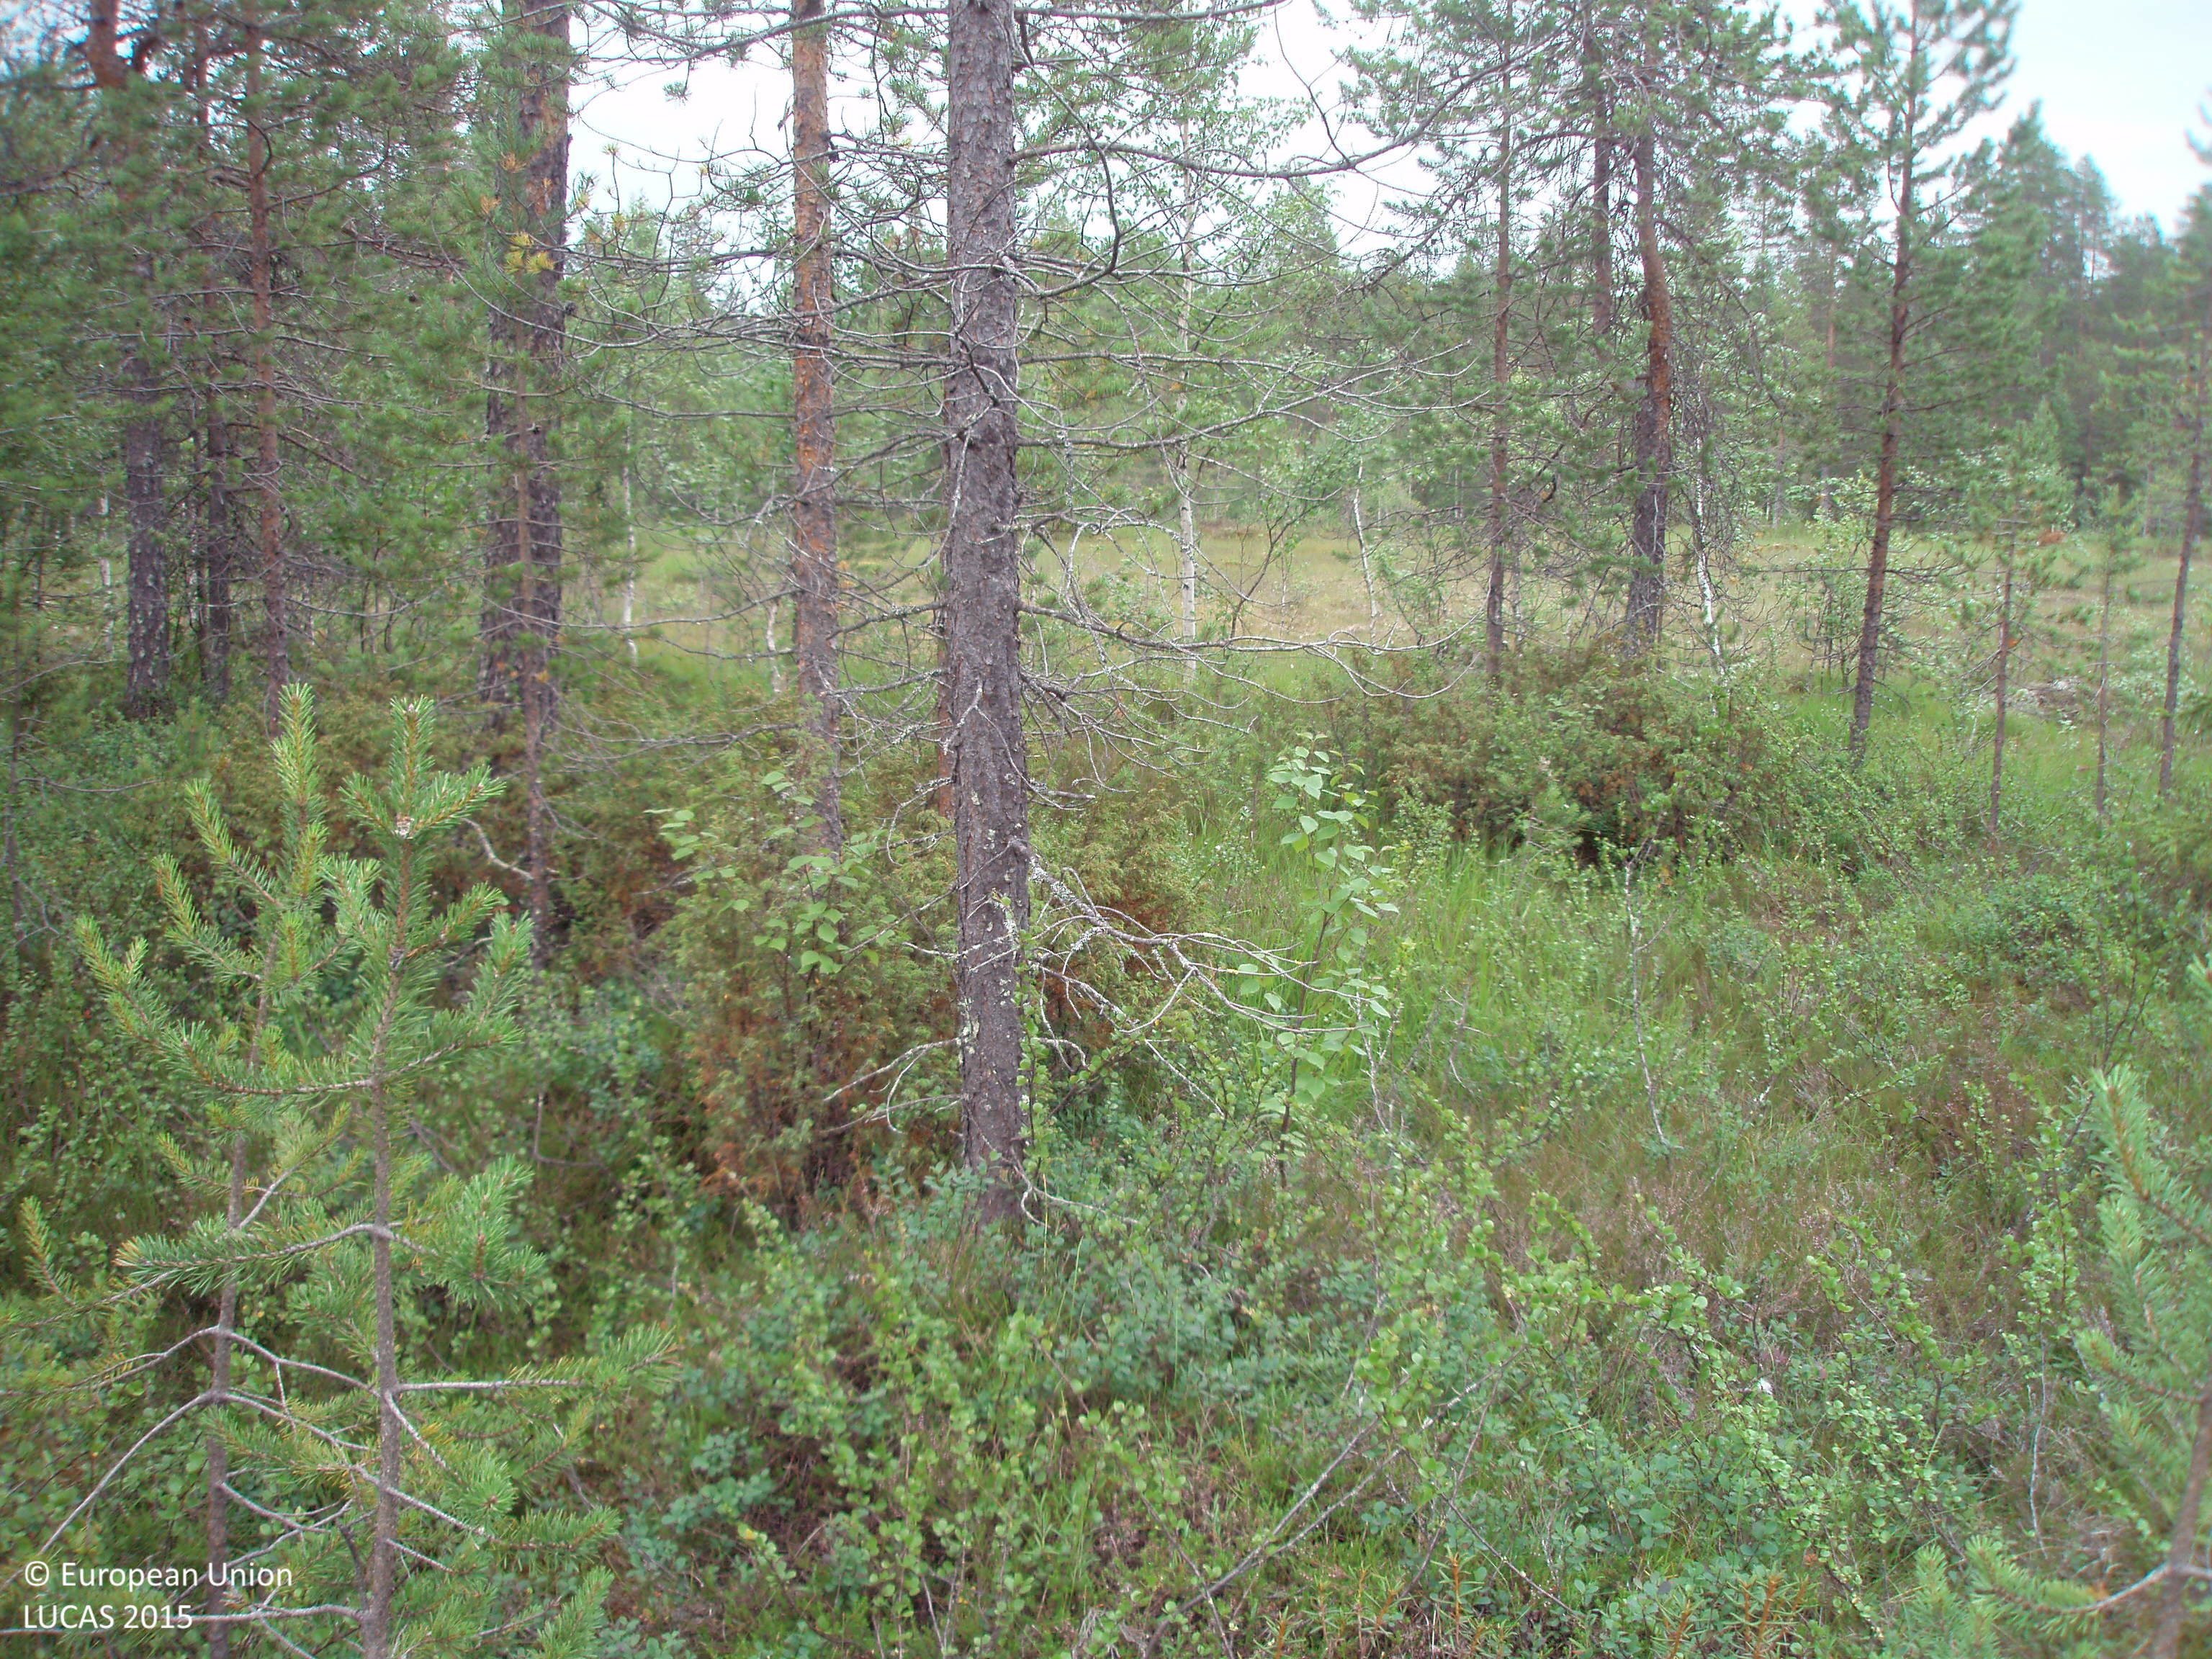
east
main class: Woodland
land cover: Other mixed woodland
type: boreal forest
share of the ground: 25 - 50 %
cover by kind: shrubs 40 %, coniferous forest trees 25 %, broadleaved forest trees 20 %, herbaceous plants 10 %, lichens and mosses 5 %
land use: Forestry
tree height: > 5 m
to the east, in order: Other mixed woodland; Ditches and canals; Peatbogs; Pine dominated mixed woodland; Ditches and canals; Pine dominated mixed woodland; Ponds and wetlands; Pine dominated mixed woodland; Other coniferous woodland; Inland fresh water bodies; Pine dominated coniferous woodland; Inland fresh water bodies; Pine dominated coniferous woodland; Artificial constructions in urban areas
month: July
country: FI
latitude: 65.6219
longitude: 27.7438
